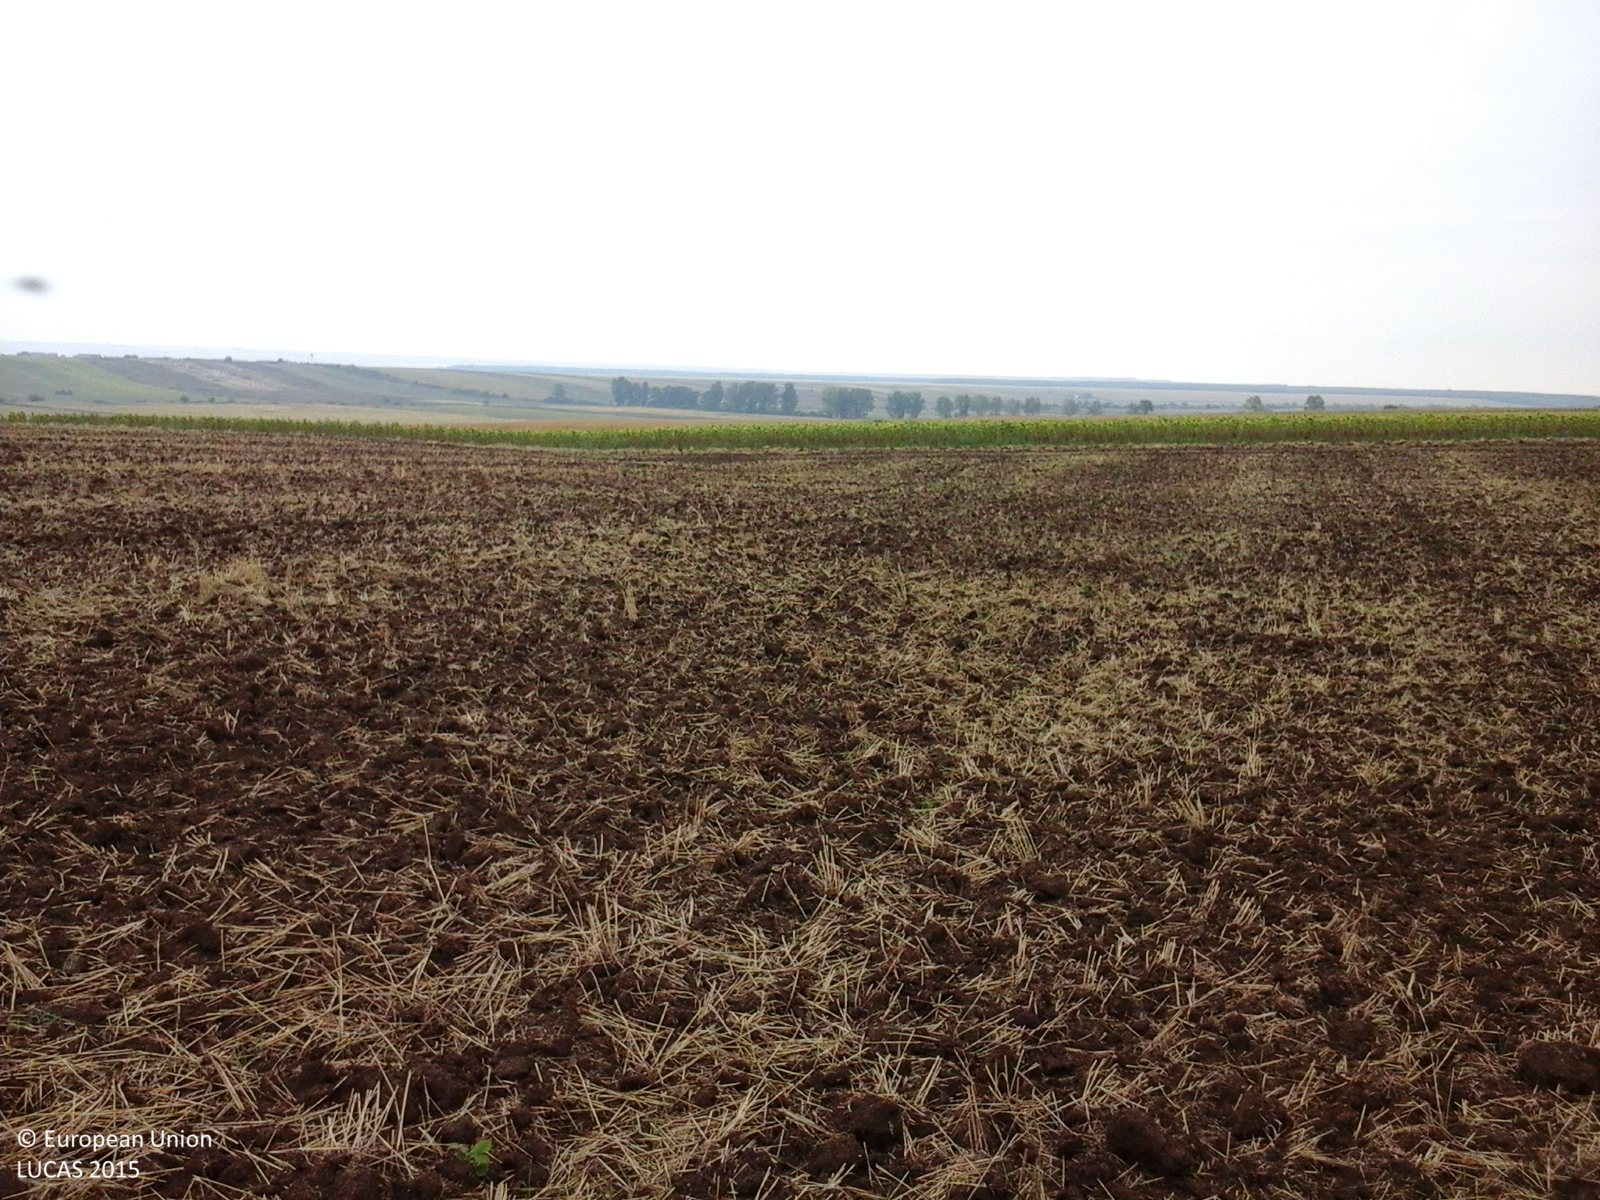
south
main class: Cropland
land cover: Common wheat
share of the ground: 25 - 50 %
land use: Agriculture (excluding fallow land and kitchen gardens)
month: August
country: RO
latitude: 45.9303
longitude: 21.3168
